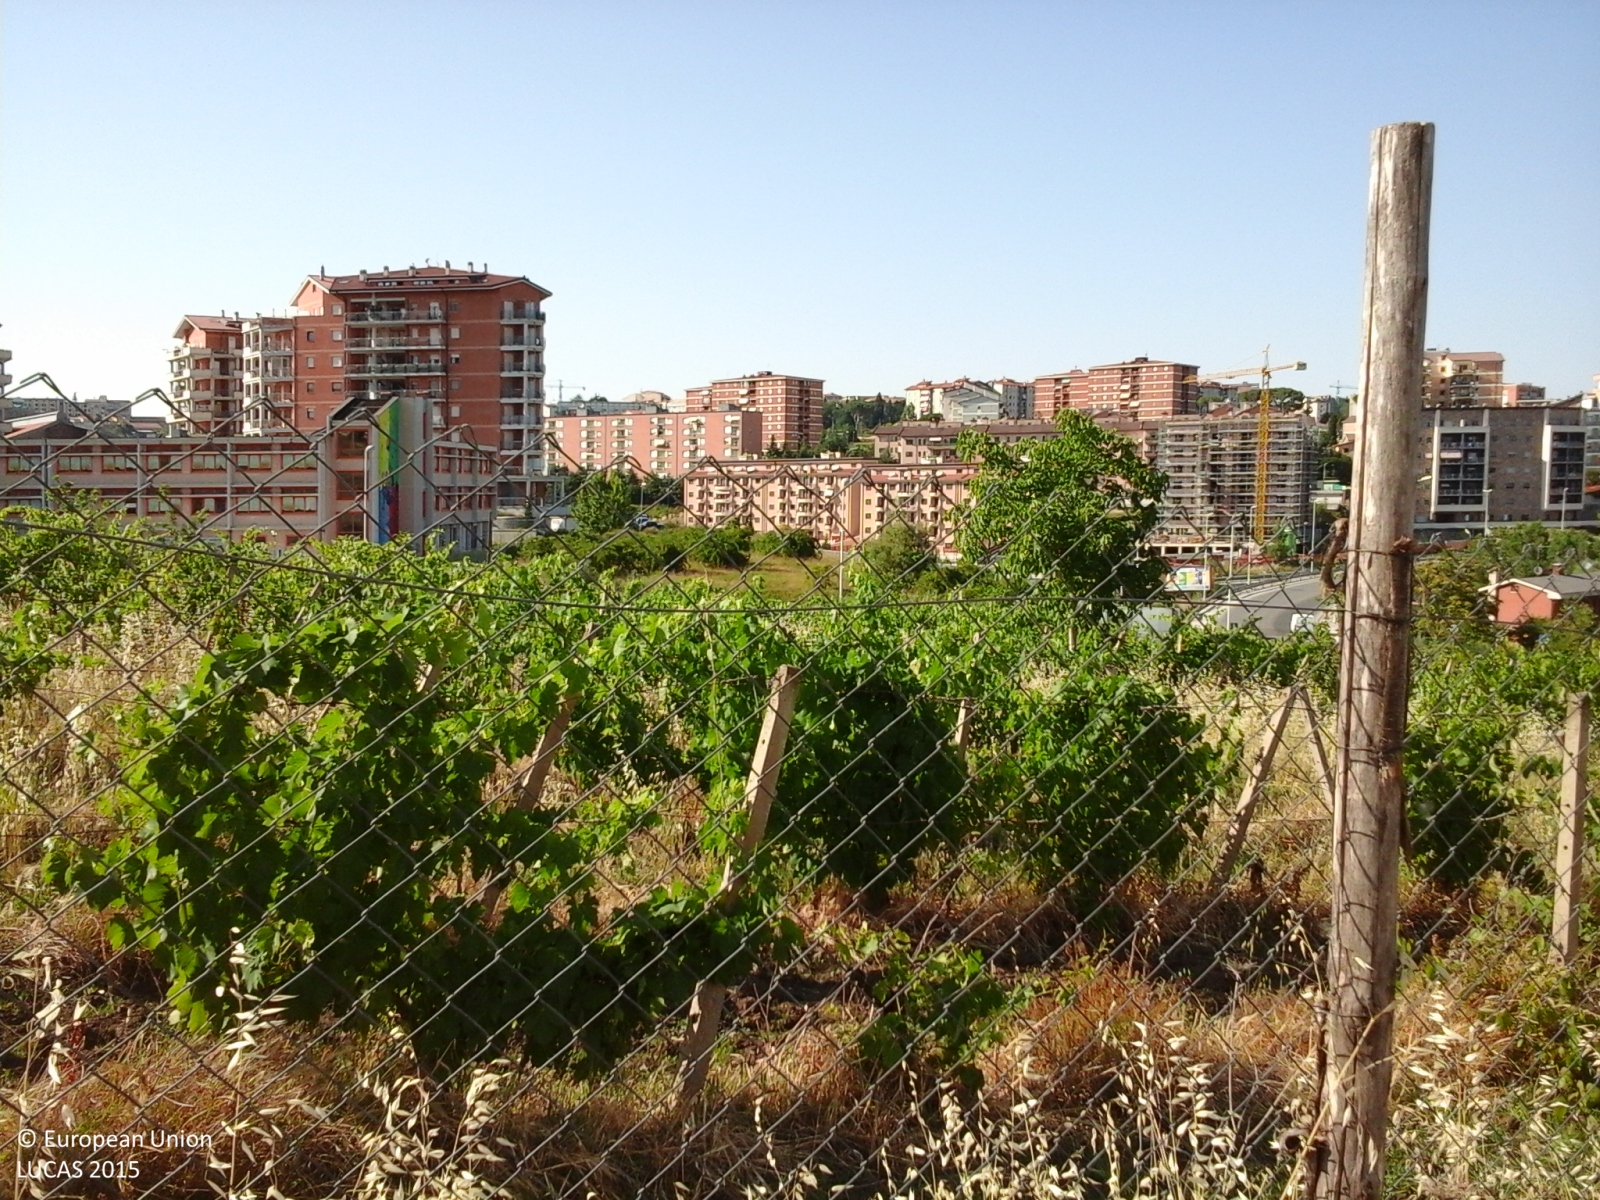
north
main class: Cropland
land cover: Vineyards
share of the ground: 50 - 75 %
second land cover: Spontaneously vegetated surfaces
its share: > 75 %
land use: Agriculture (excluding fallow land and kitchen gardens)
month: July
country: IT
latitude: 41.5510
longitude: 14.6714
